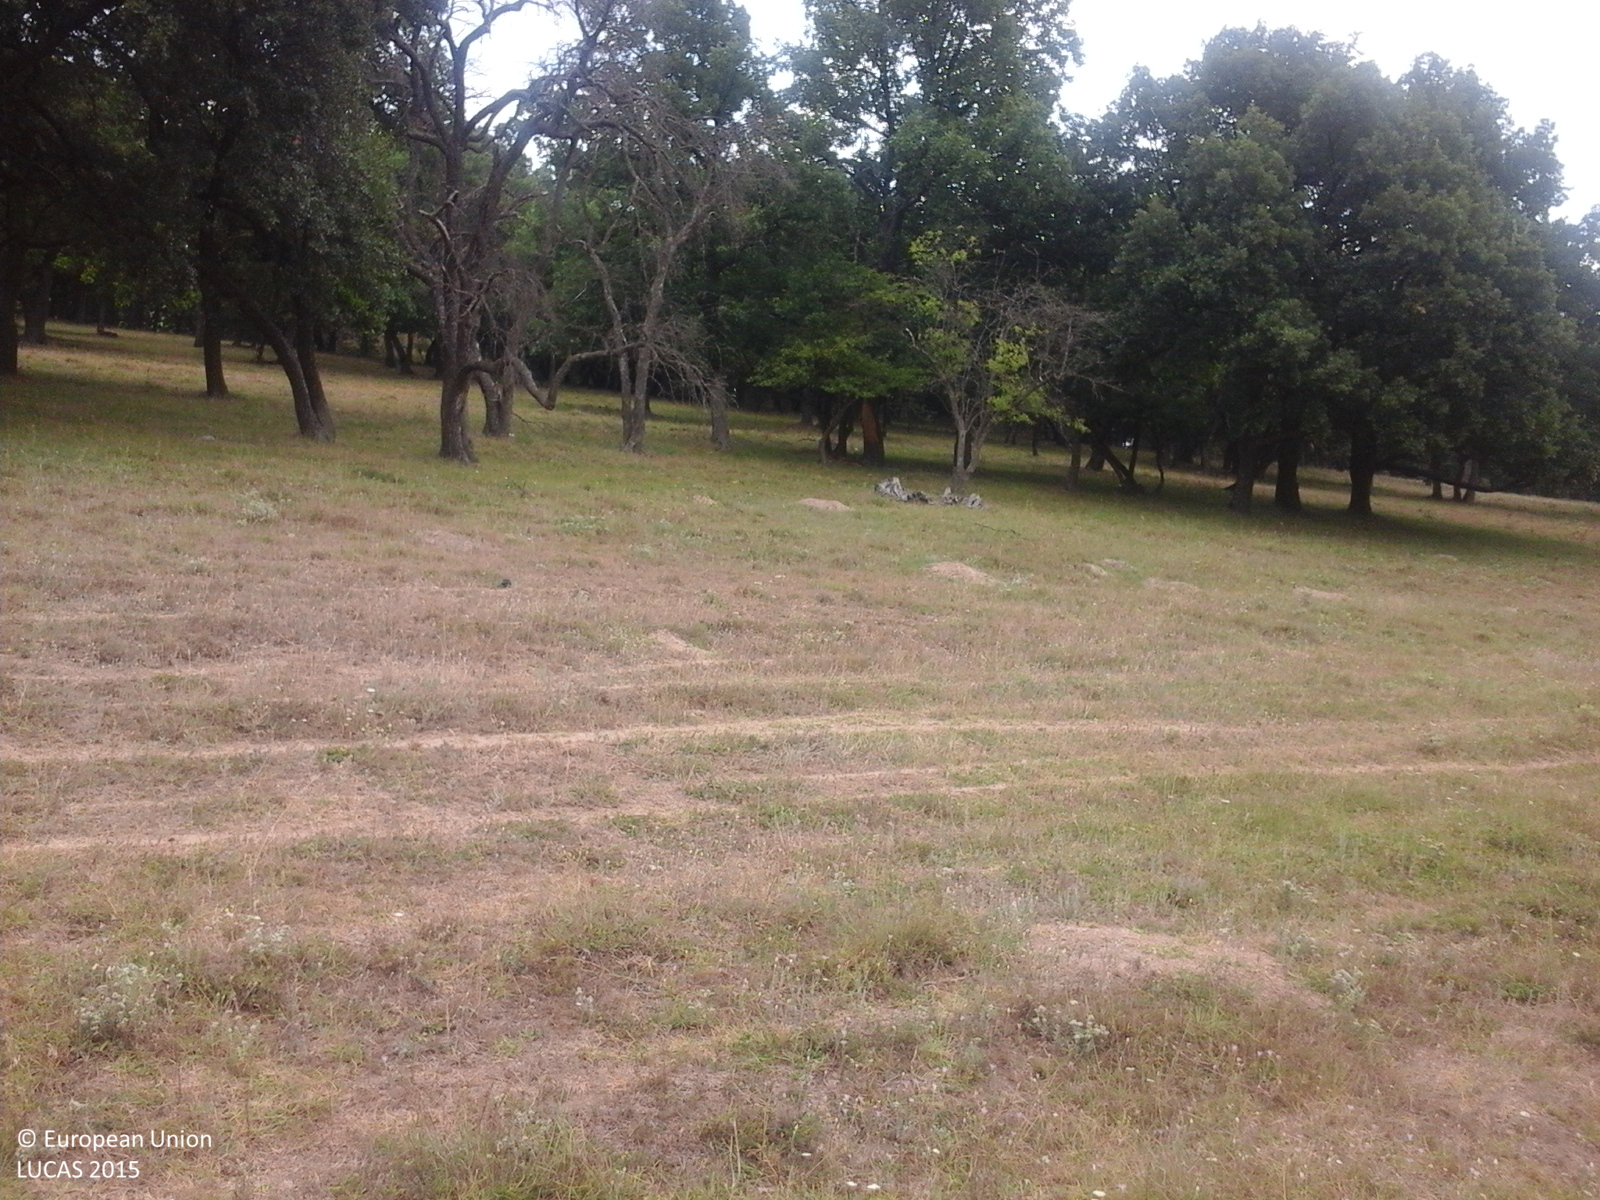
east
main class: Grassland
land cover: Grassland without tree/shrub cover
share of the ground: > 75 %
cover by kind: herbaceous plants 100 %
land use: Agriculture (excluding fallow land and kitchen gardens)
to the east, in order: Grassland without tree/shrub cover; Tracks; Grassland without tree/shrub cover; Broadleaved woodland
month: July
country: RO
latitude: 44.9028
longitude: 28.5041
